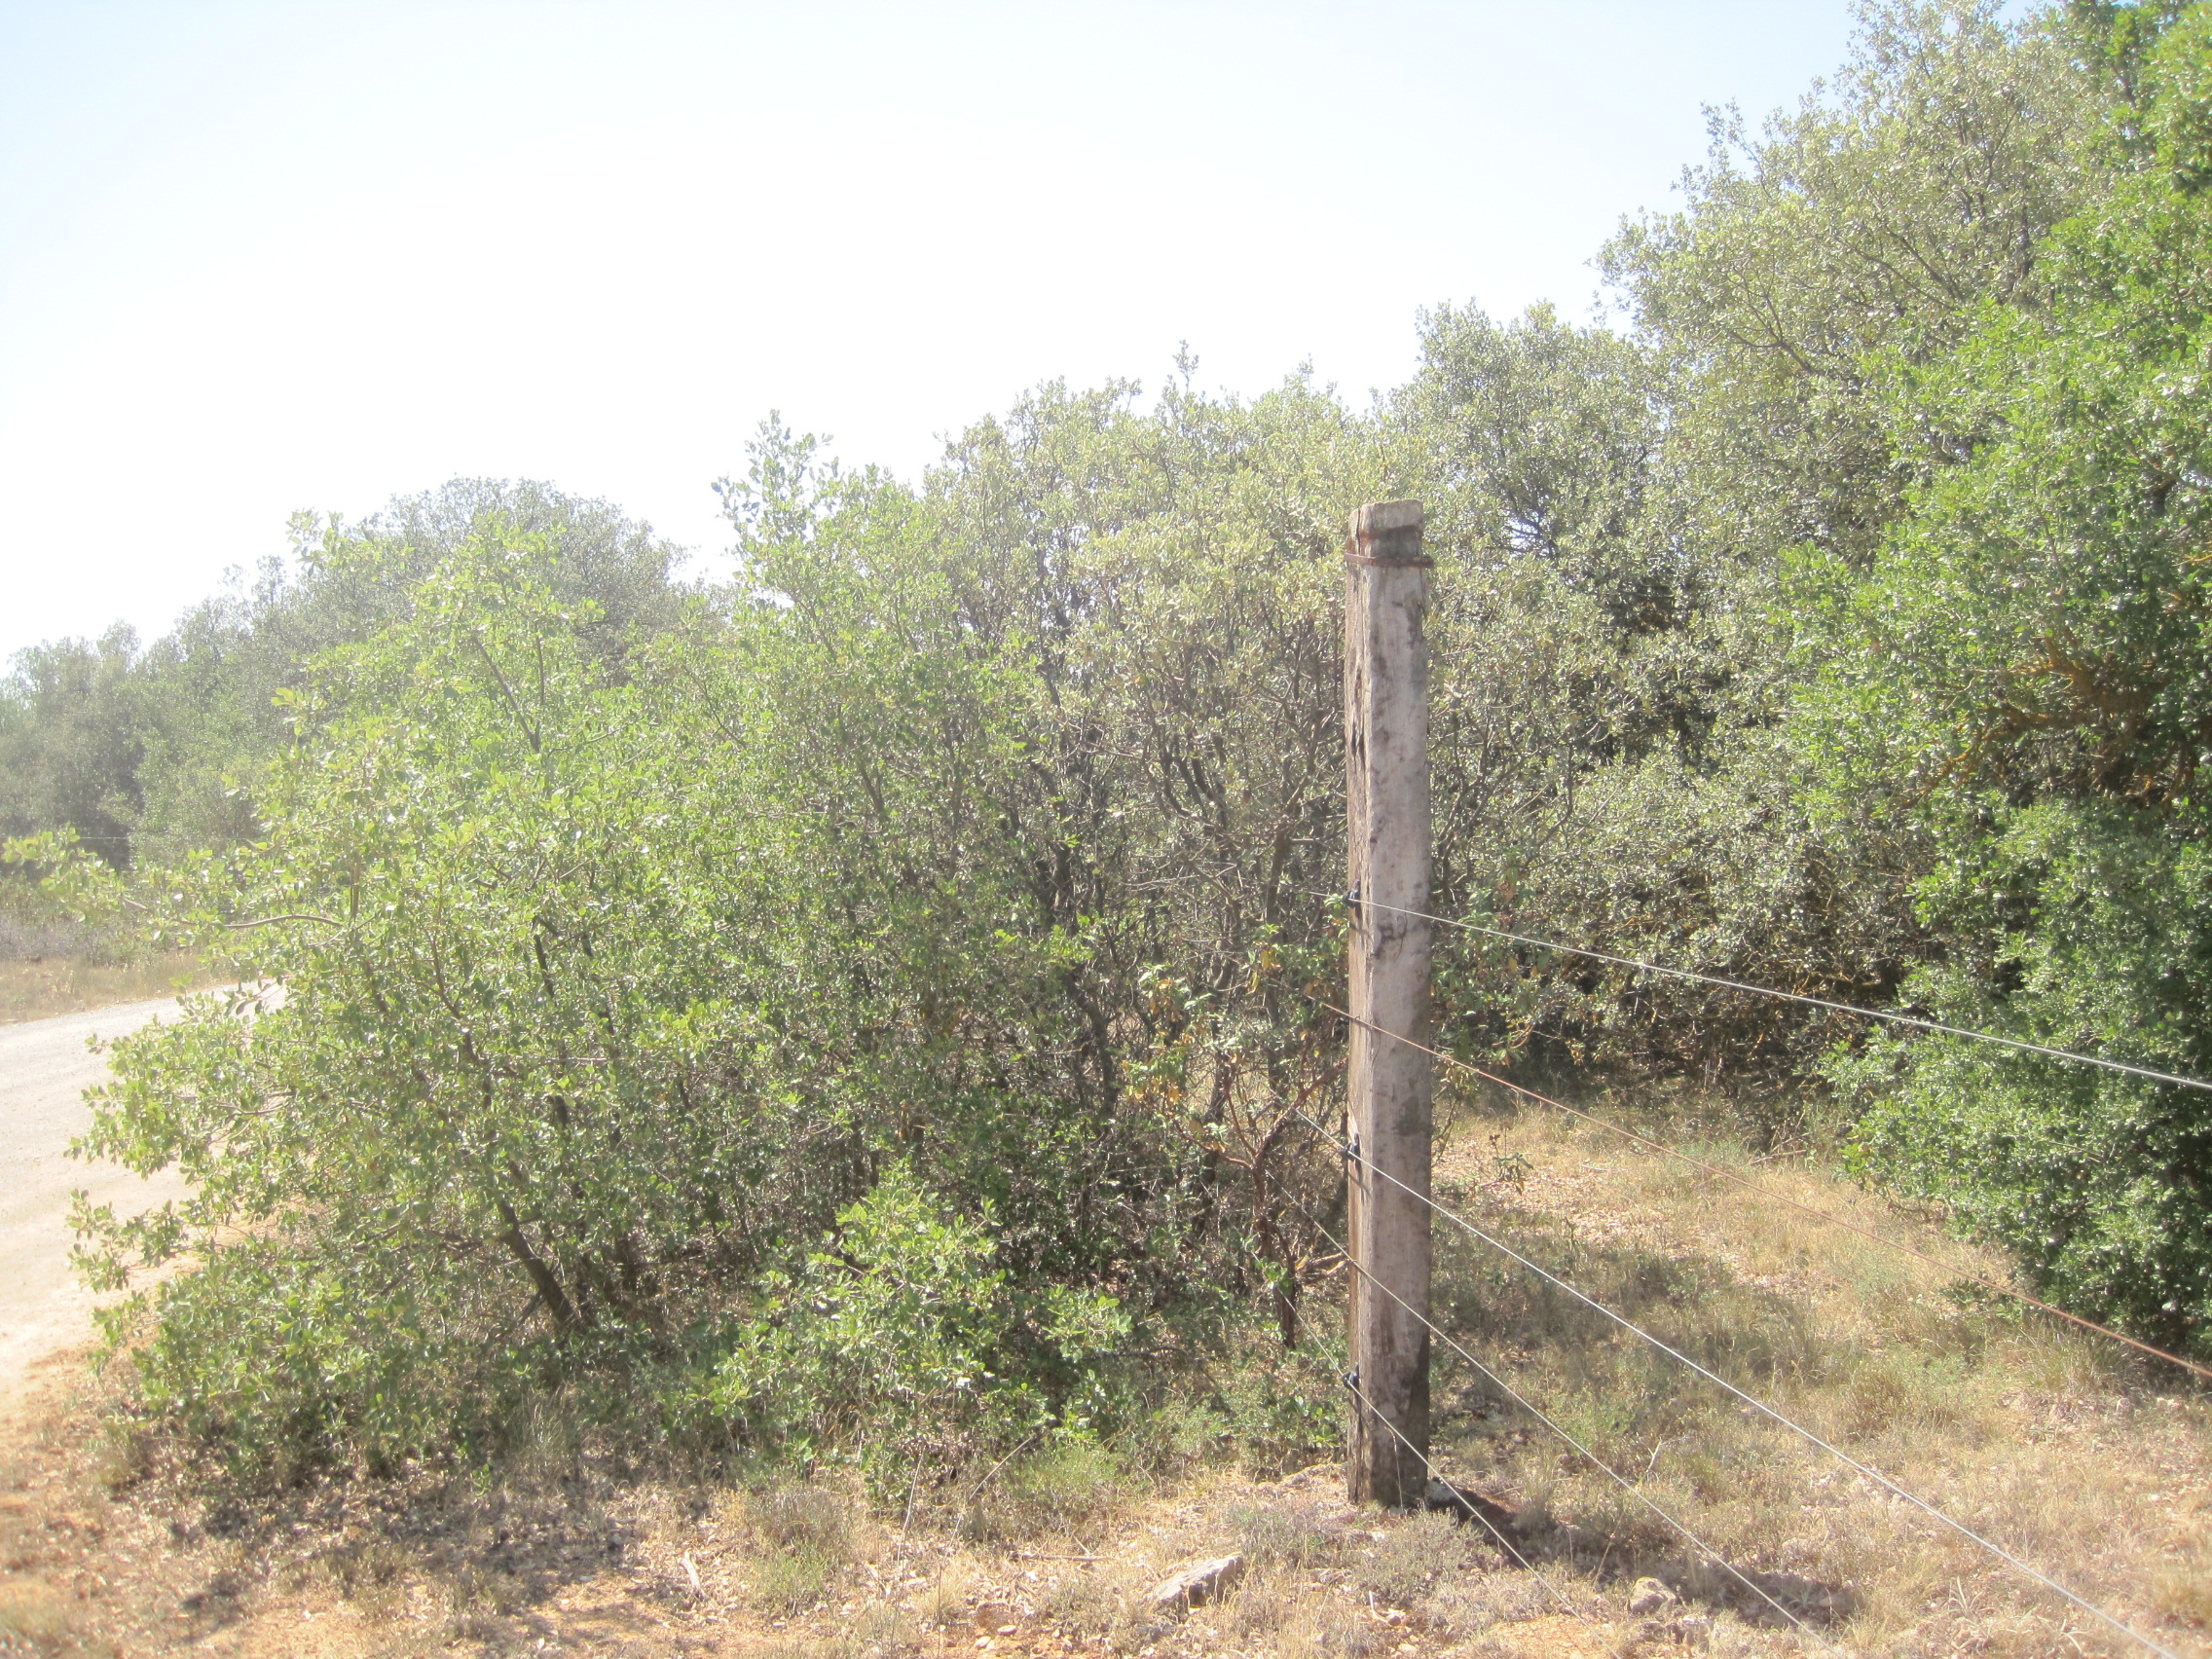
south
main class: Woodland
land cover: Broadleaved woodland
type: broadleaved evergreen forest
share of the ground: 50 - 75 %
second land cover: Grassland without tree/shrub cover
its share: 50 - 75 %
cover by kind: broadleaved forest trees 70 %, herbaceous plants 30 %
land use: Forestry
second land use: Agriculture (excluding fallow land and kitchen gardens)
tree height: > 5 m
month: July
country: ES
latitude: 41.7672
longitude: -5.1262
